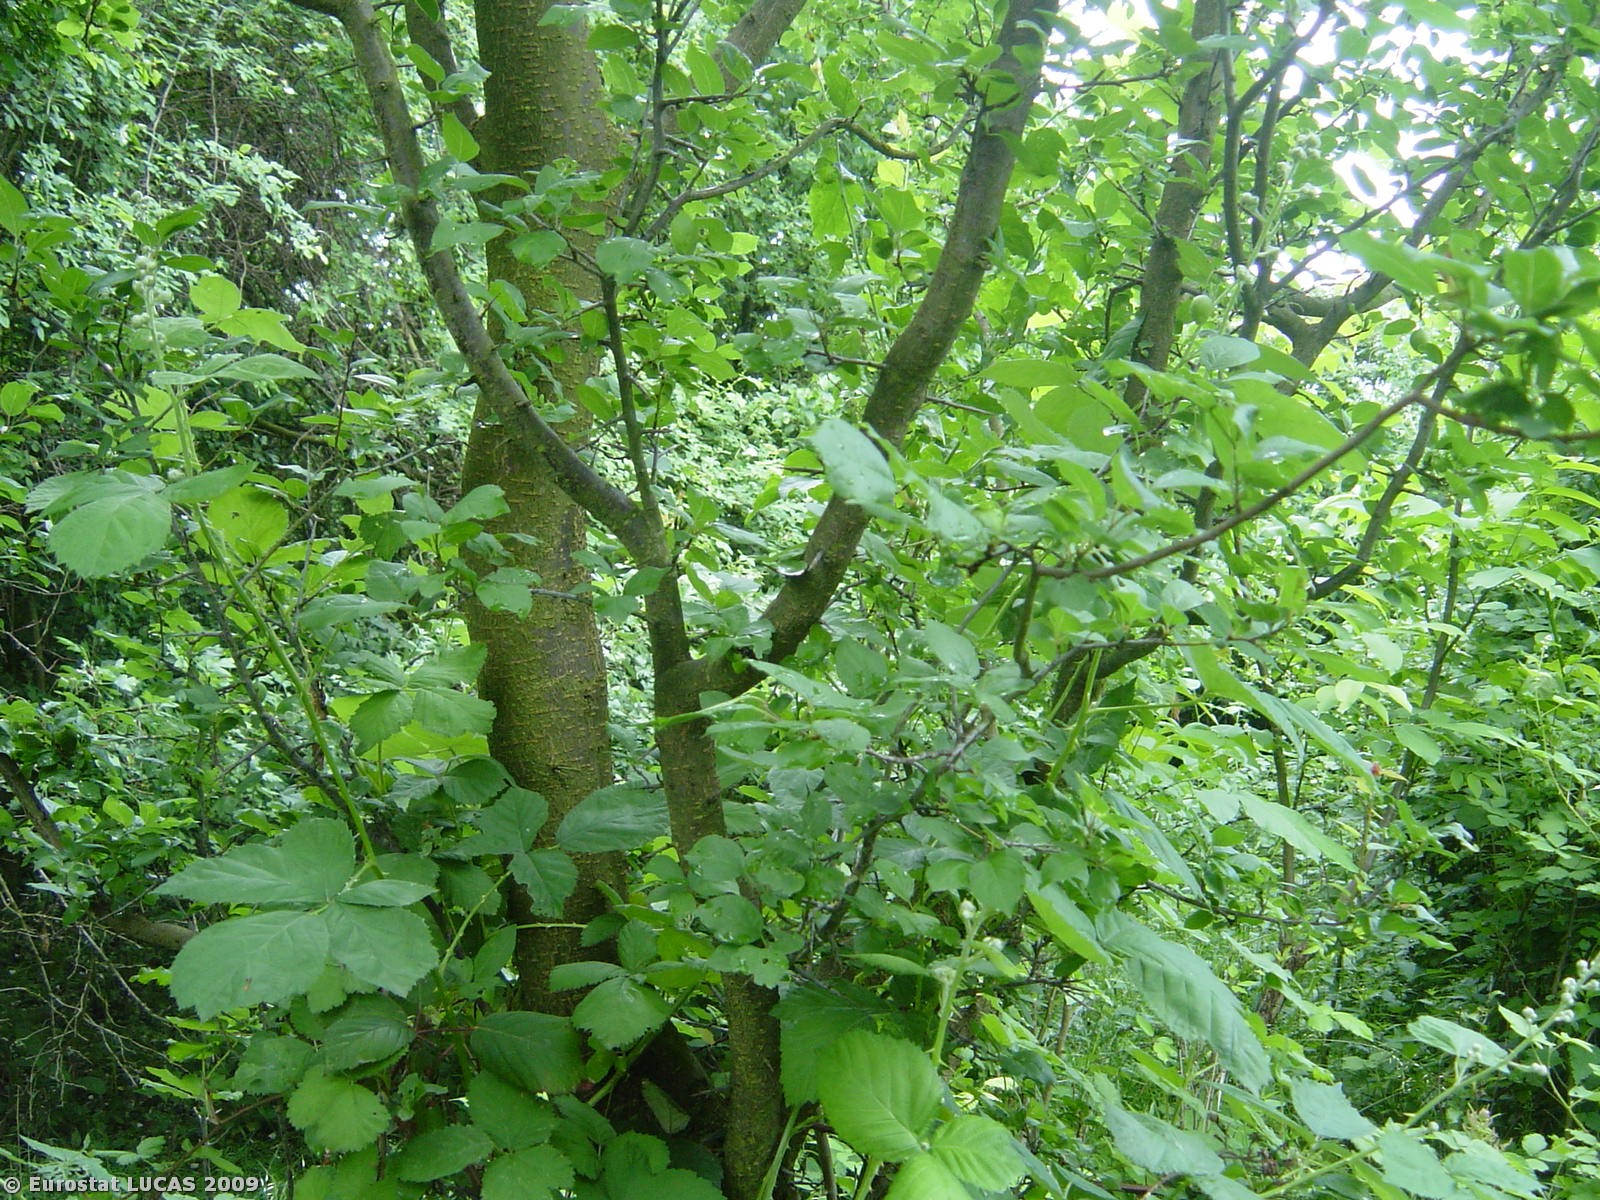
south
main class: Cropland
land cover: Other fruit trees and berries
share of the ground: 50 - 75 %
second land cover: Grassland with sparse tree/shrub cover
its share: > 75 %
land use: Fallow land
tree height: > 5 m
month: June
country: CZ
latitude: 49.1453
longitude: 17.4553
